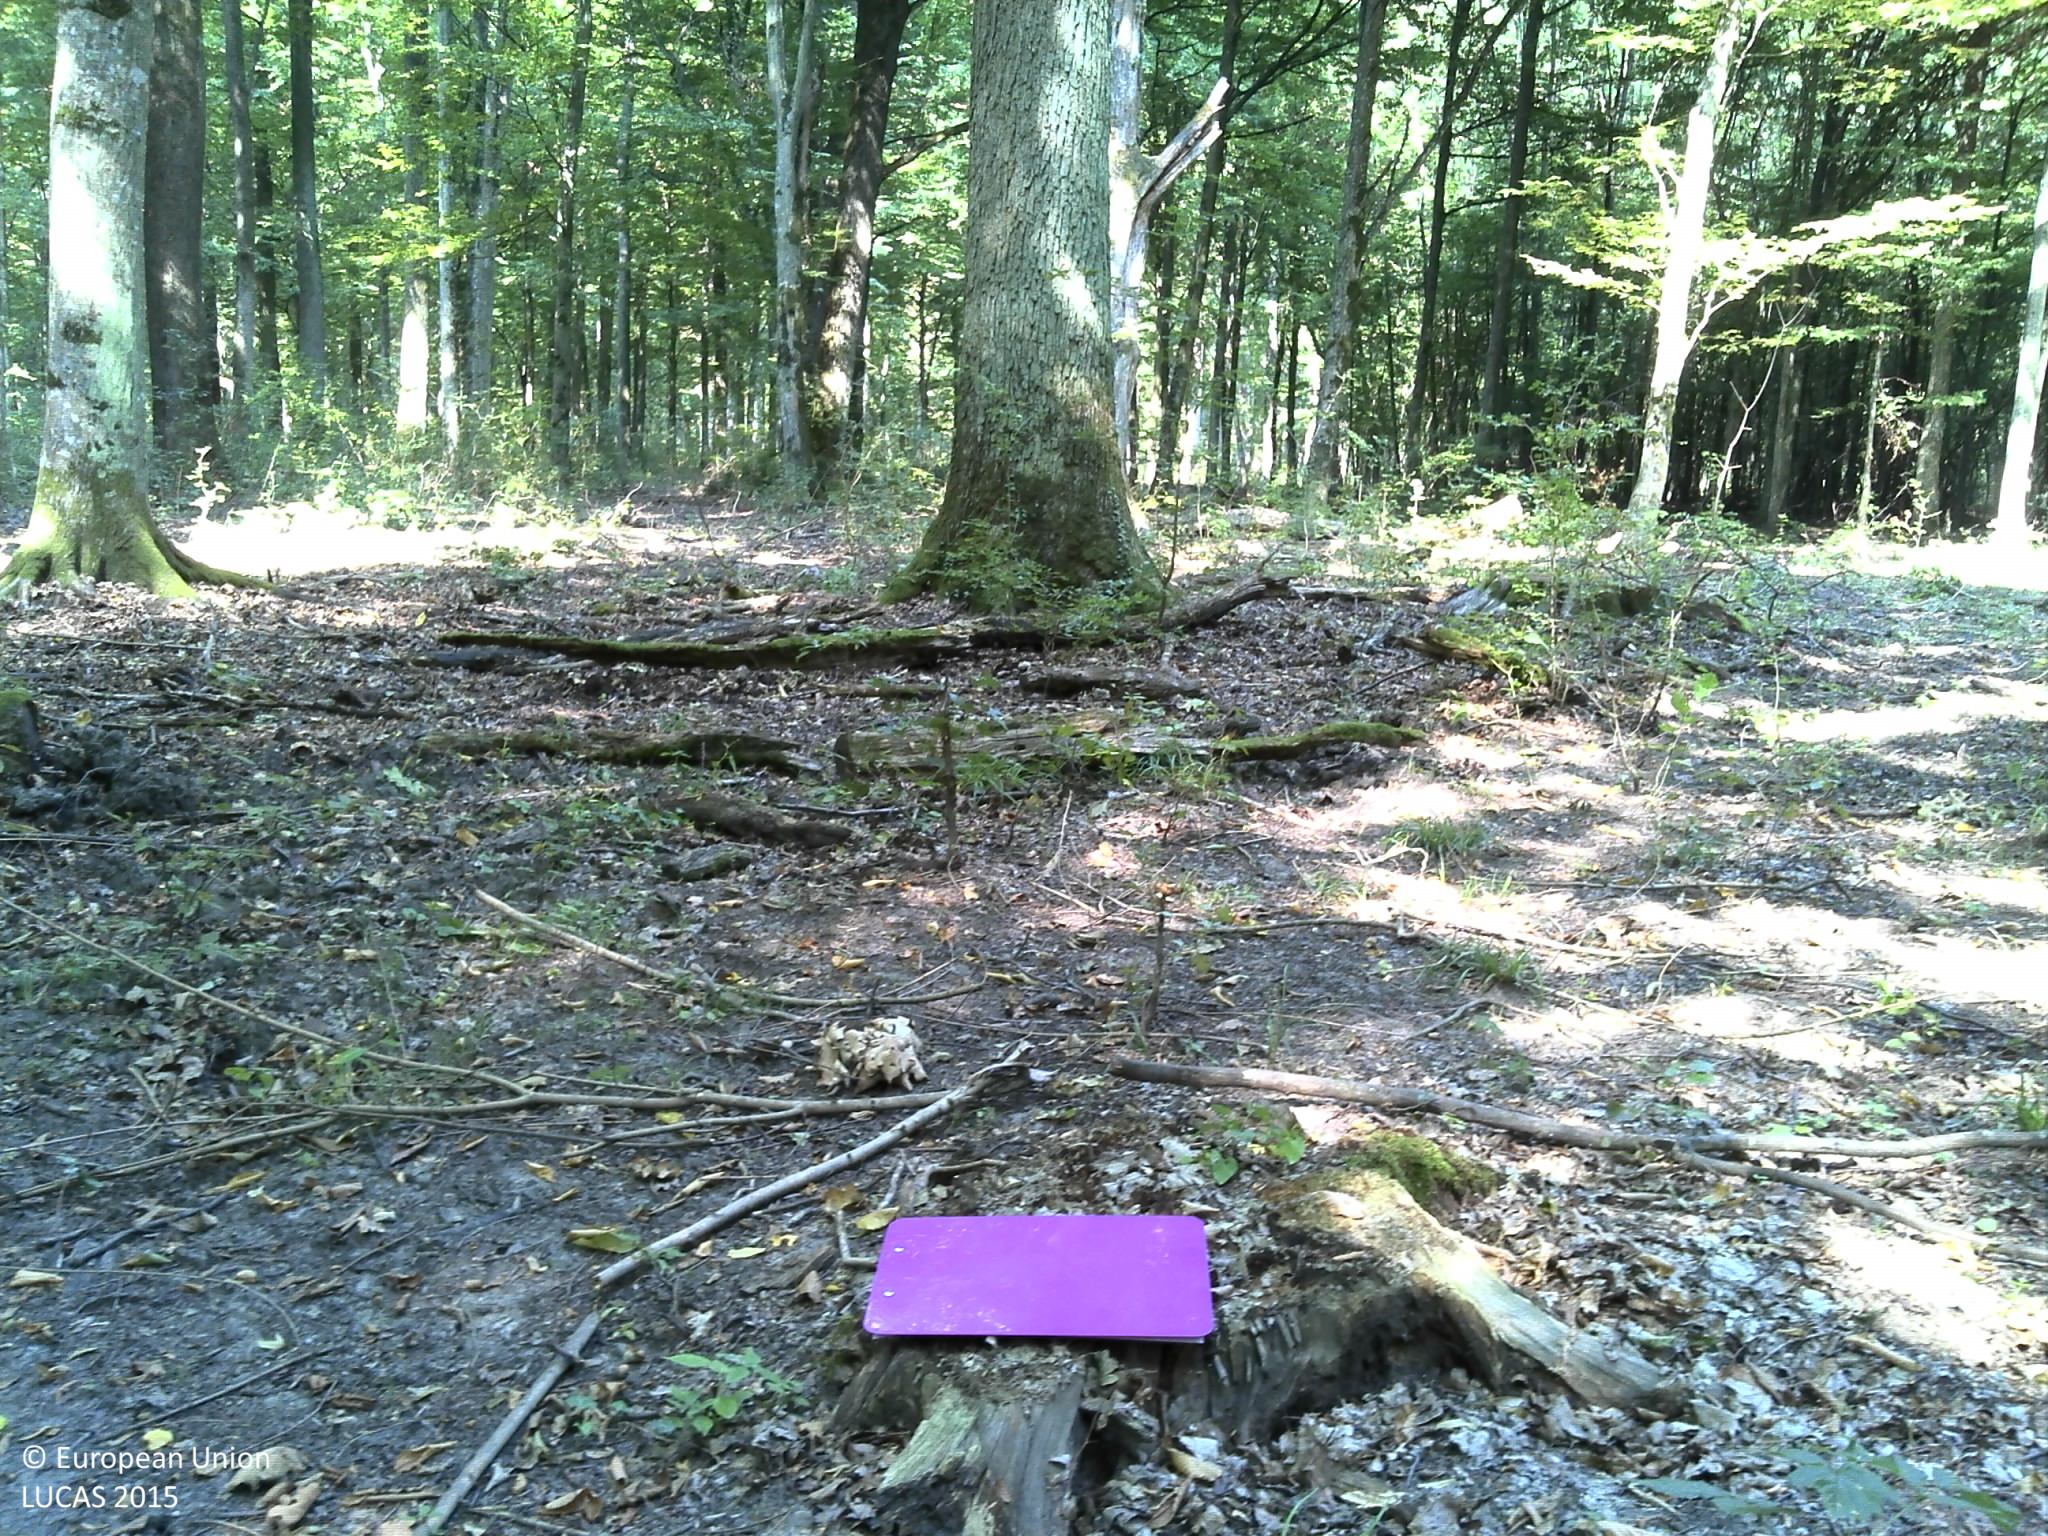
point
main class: Woodland
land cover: Broadleaved woodland
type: acidophilous oak and oak-birch forest
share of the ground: > 75 %
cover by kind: broadleaved forest trees 100 %
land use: Forestry
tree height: > 5 m
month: August
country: HR
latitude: 45.1169
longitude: 18.8158
